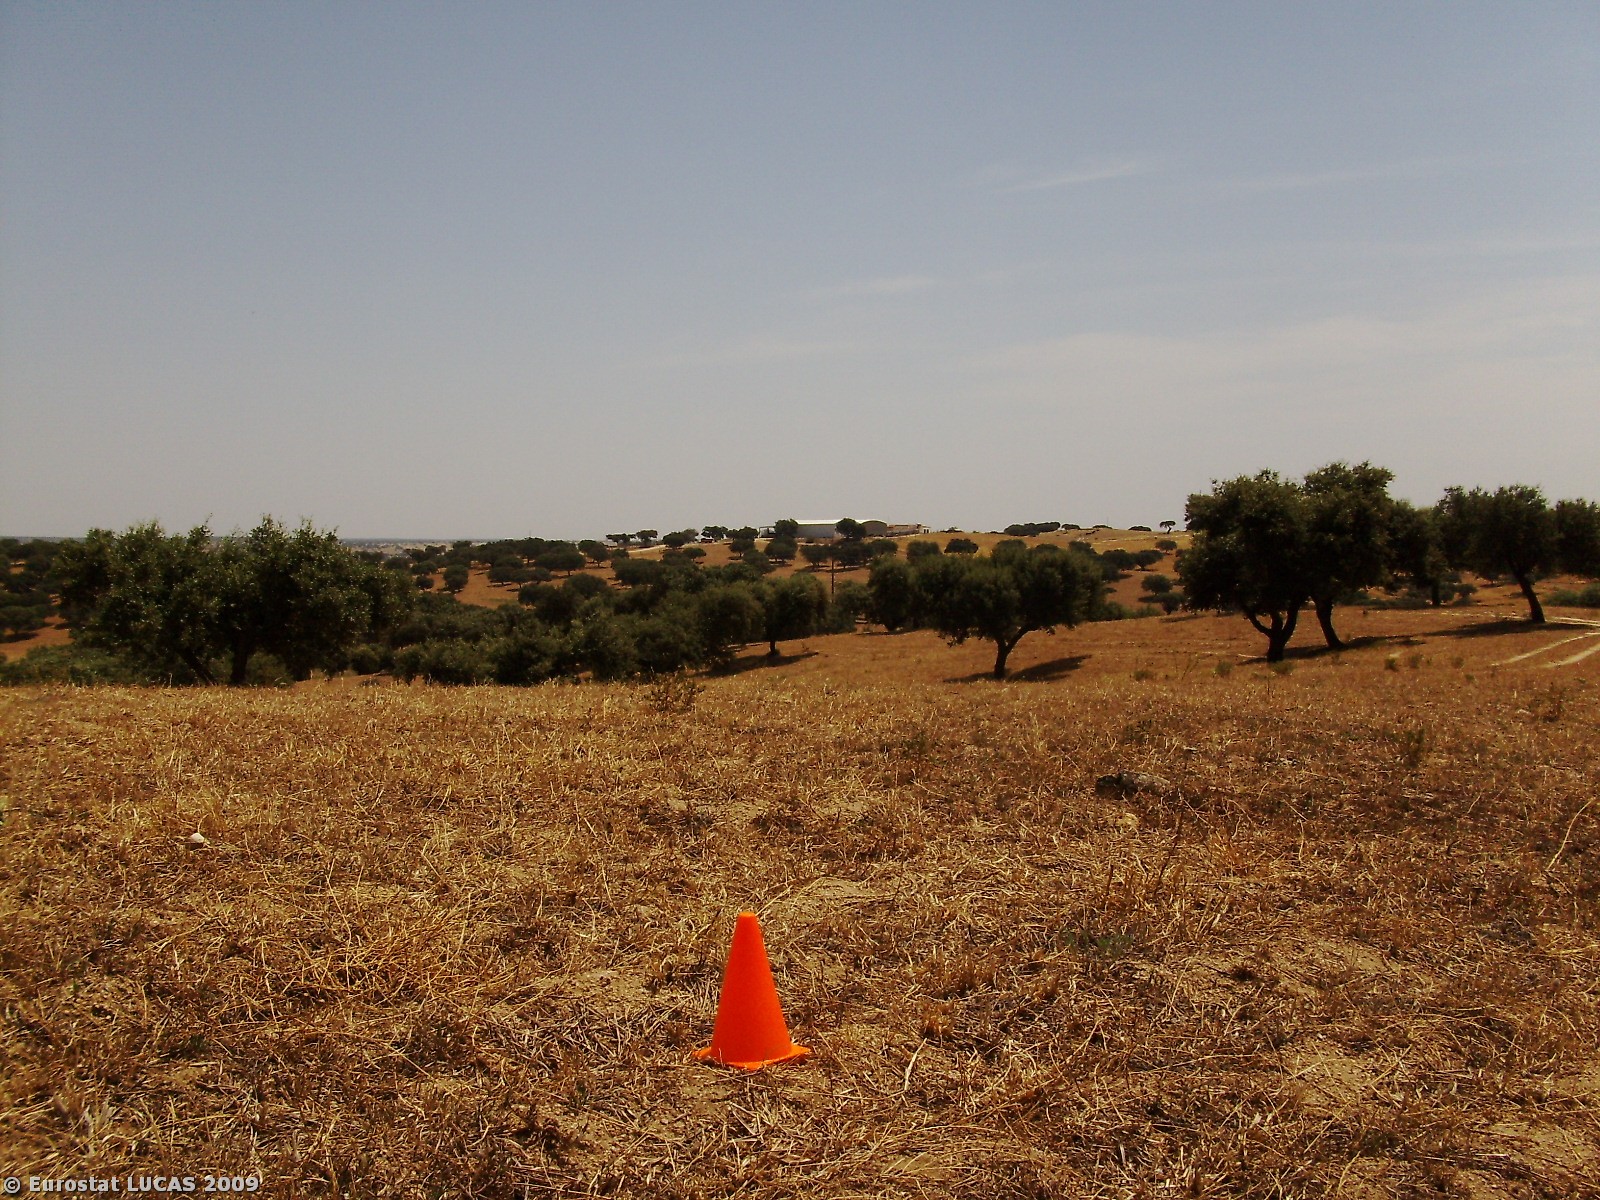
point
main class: Grassland
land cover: Grassland without tree/shrub cover
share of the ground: > 75 %
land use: Agriculture (excluding fallow land and kitchen gardens)
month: June
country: PT
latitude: 39.0873
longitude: -7.2951
